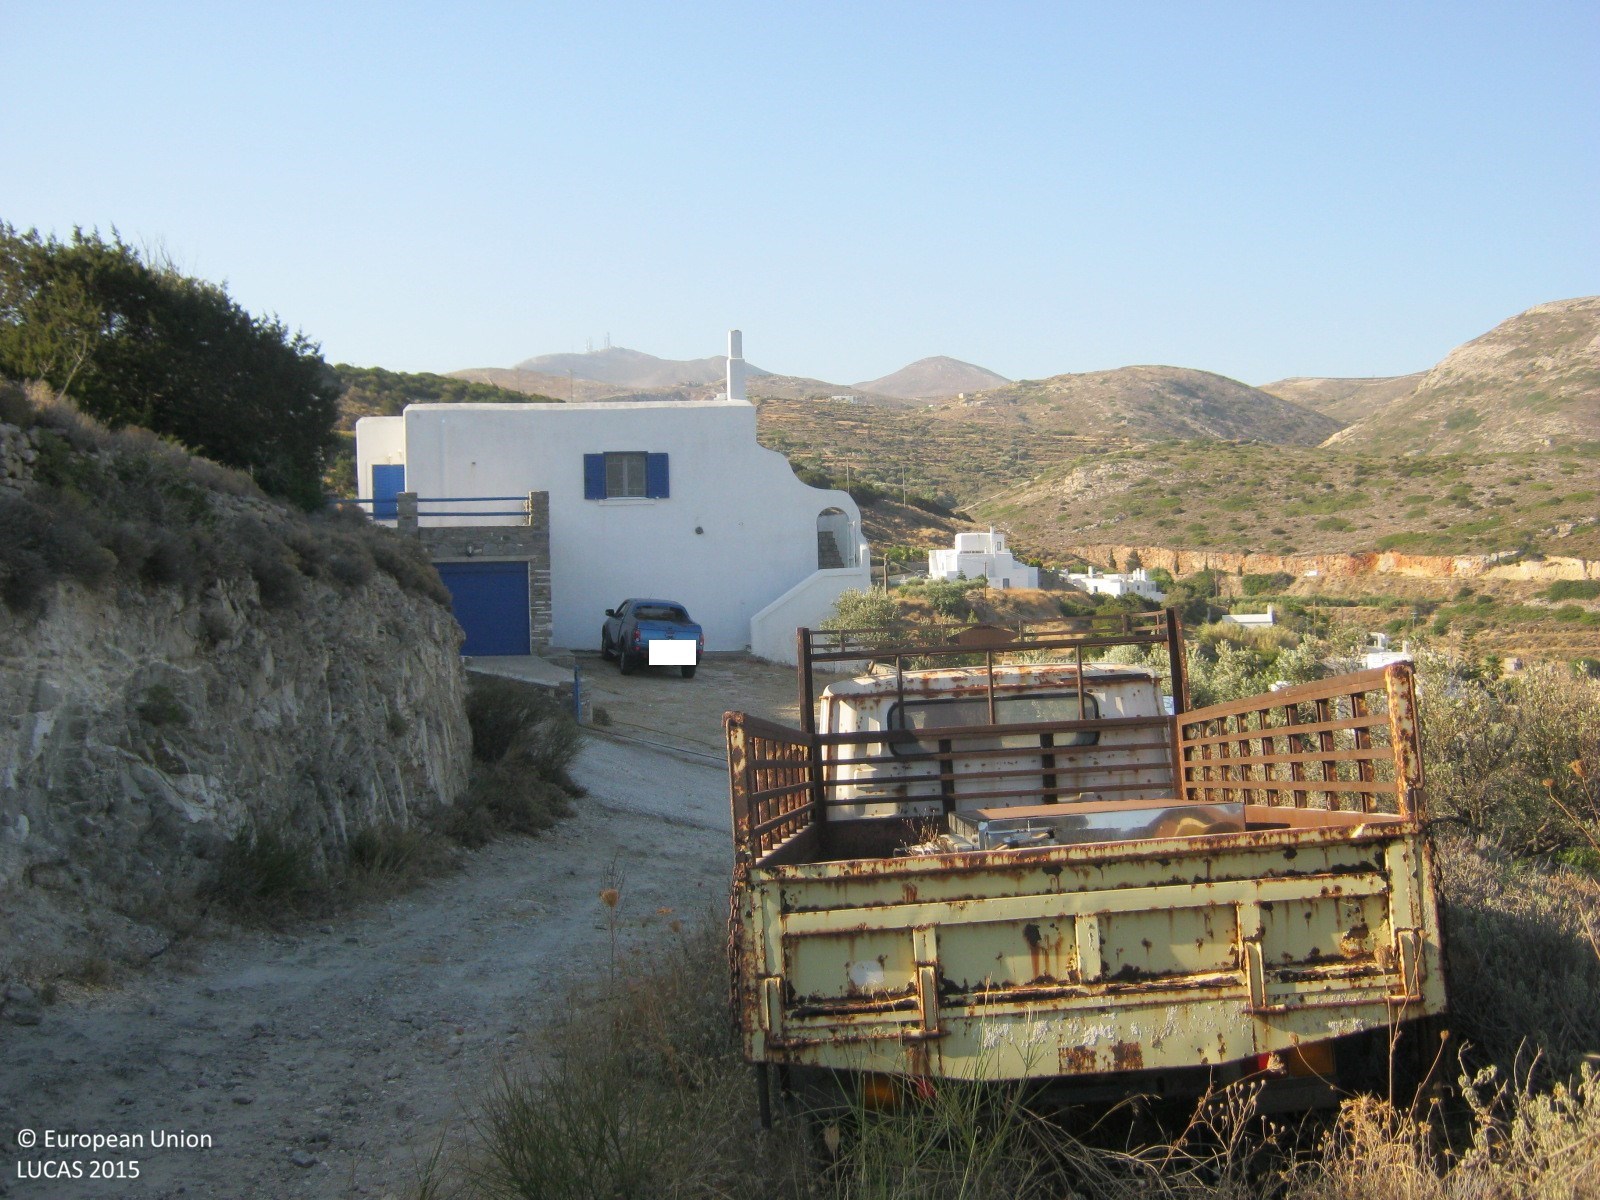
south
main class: Shrubland
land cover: Shrubland without tree cover
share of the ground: > 75 %
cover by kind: shrubs 80 %, herbaceous plants 10 %, unconsolidated bare surface 10 %
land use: Residential
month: August
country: GR
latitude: 37.0915
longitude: 25.1829
